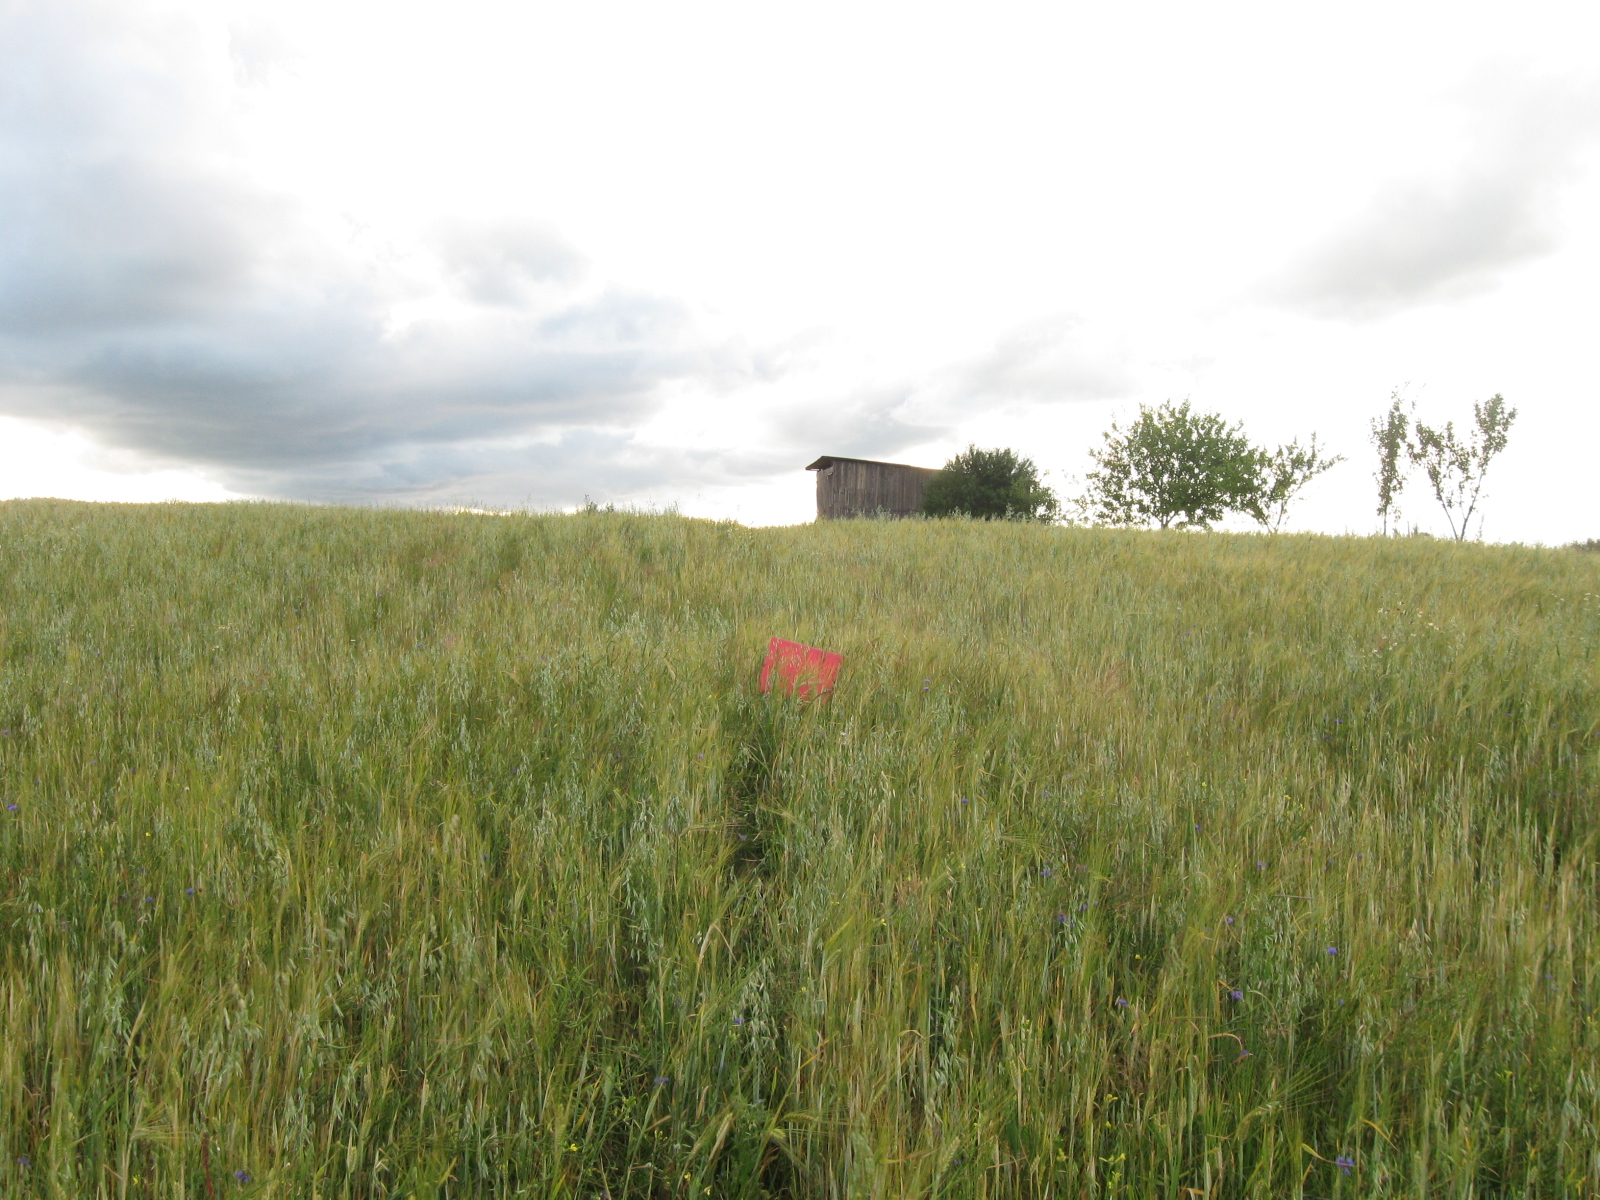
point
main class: Cropland
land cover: Barley
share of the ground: > 75 %
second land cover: Oats
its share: 10 - 25 %
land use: Agriculture (excluding fallow land and kitchen gardens)
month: July
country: LT
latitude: 54.3496
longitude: 24.3621
